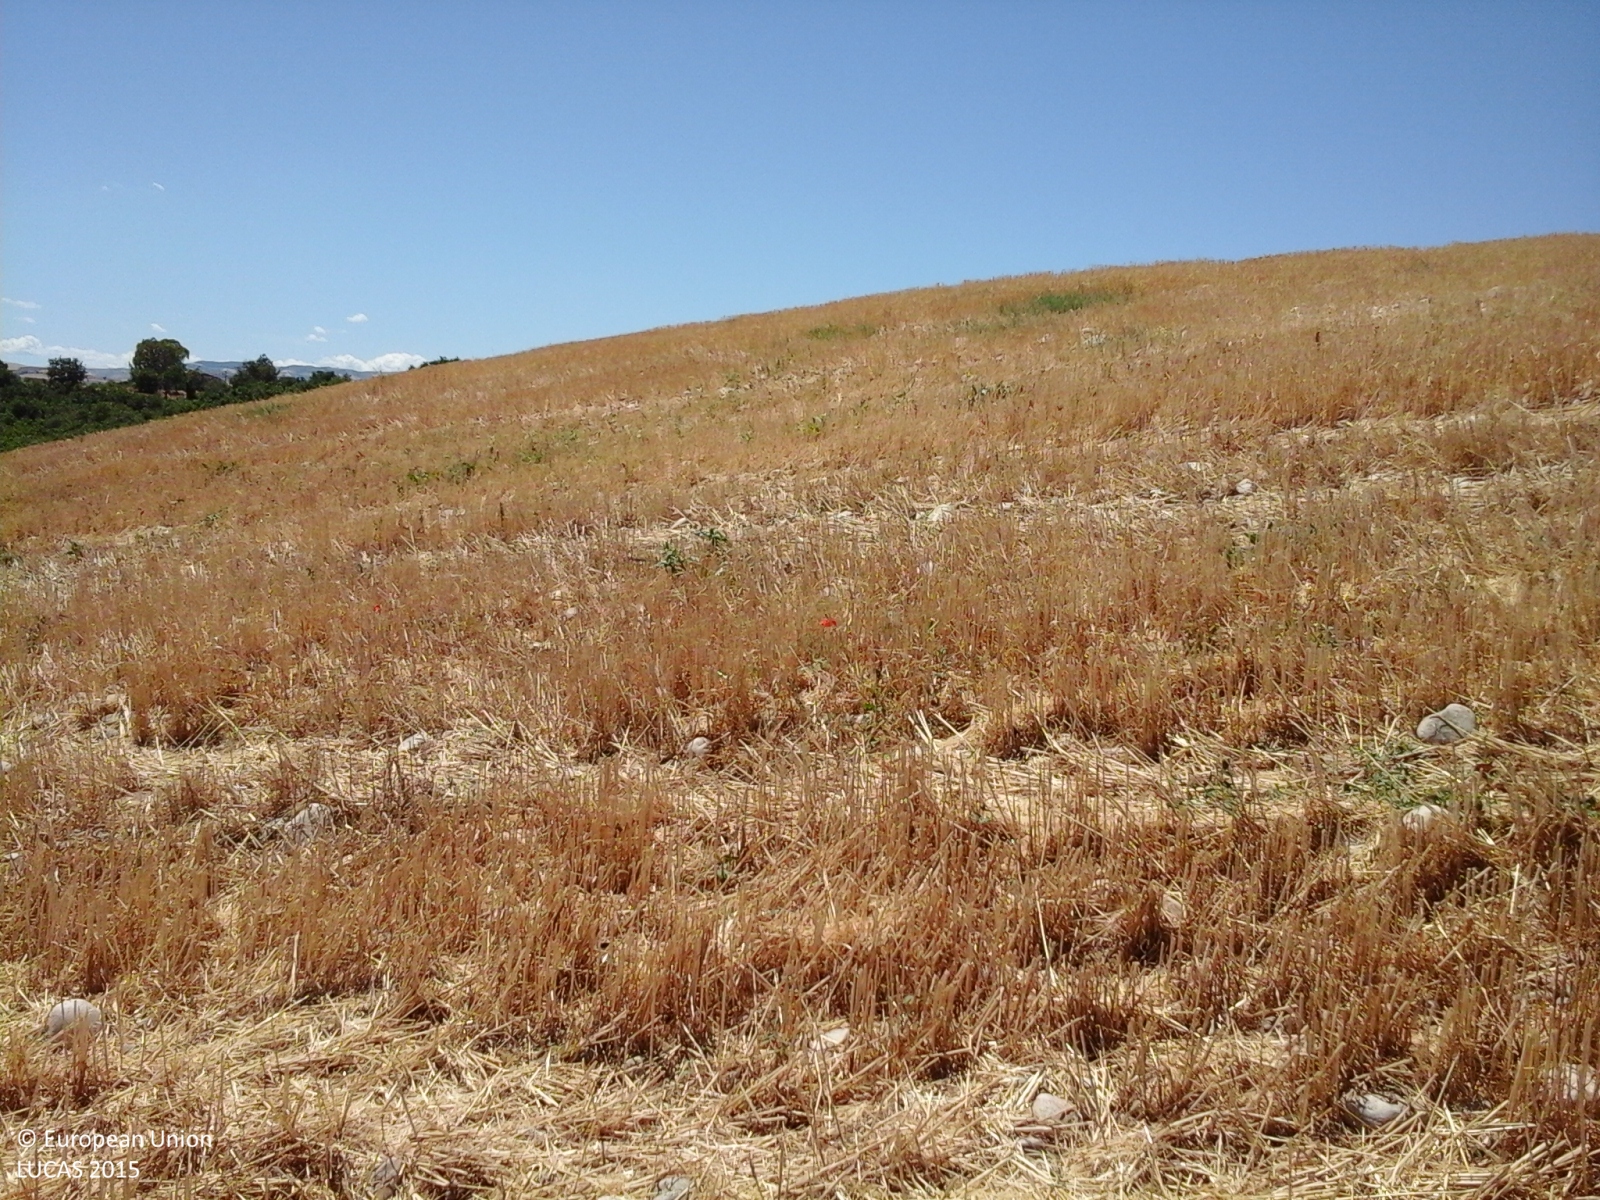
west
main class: Cropland
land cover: Durum wheat
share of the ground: > 75 %
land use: Agriculture (excluding fallow land and kitchen gardens)
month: June
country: IT
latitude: 41.7090
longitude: 15.1393
